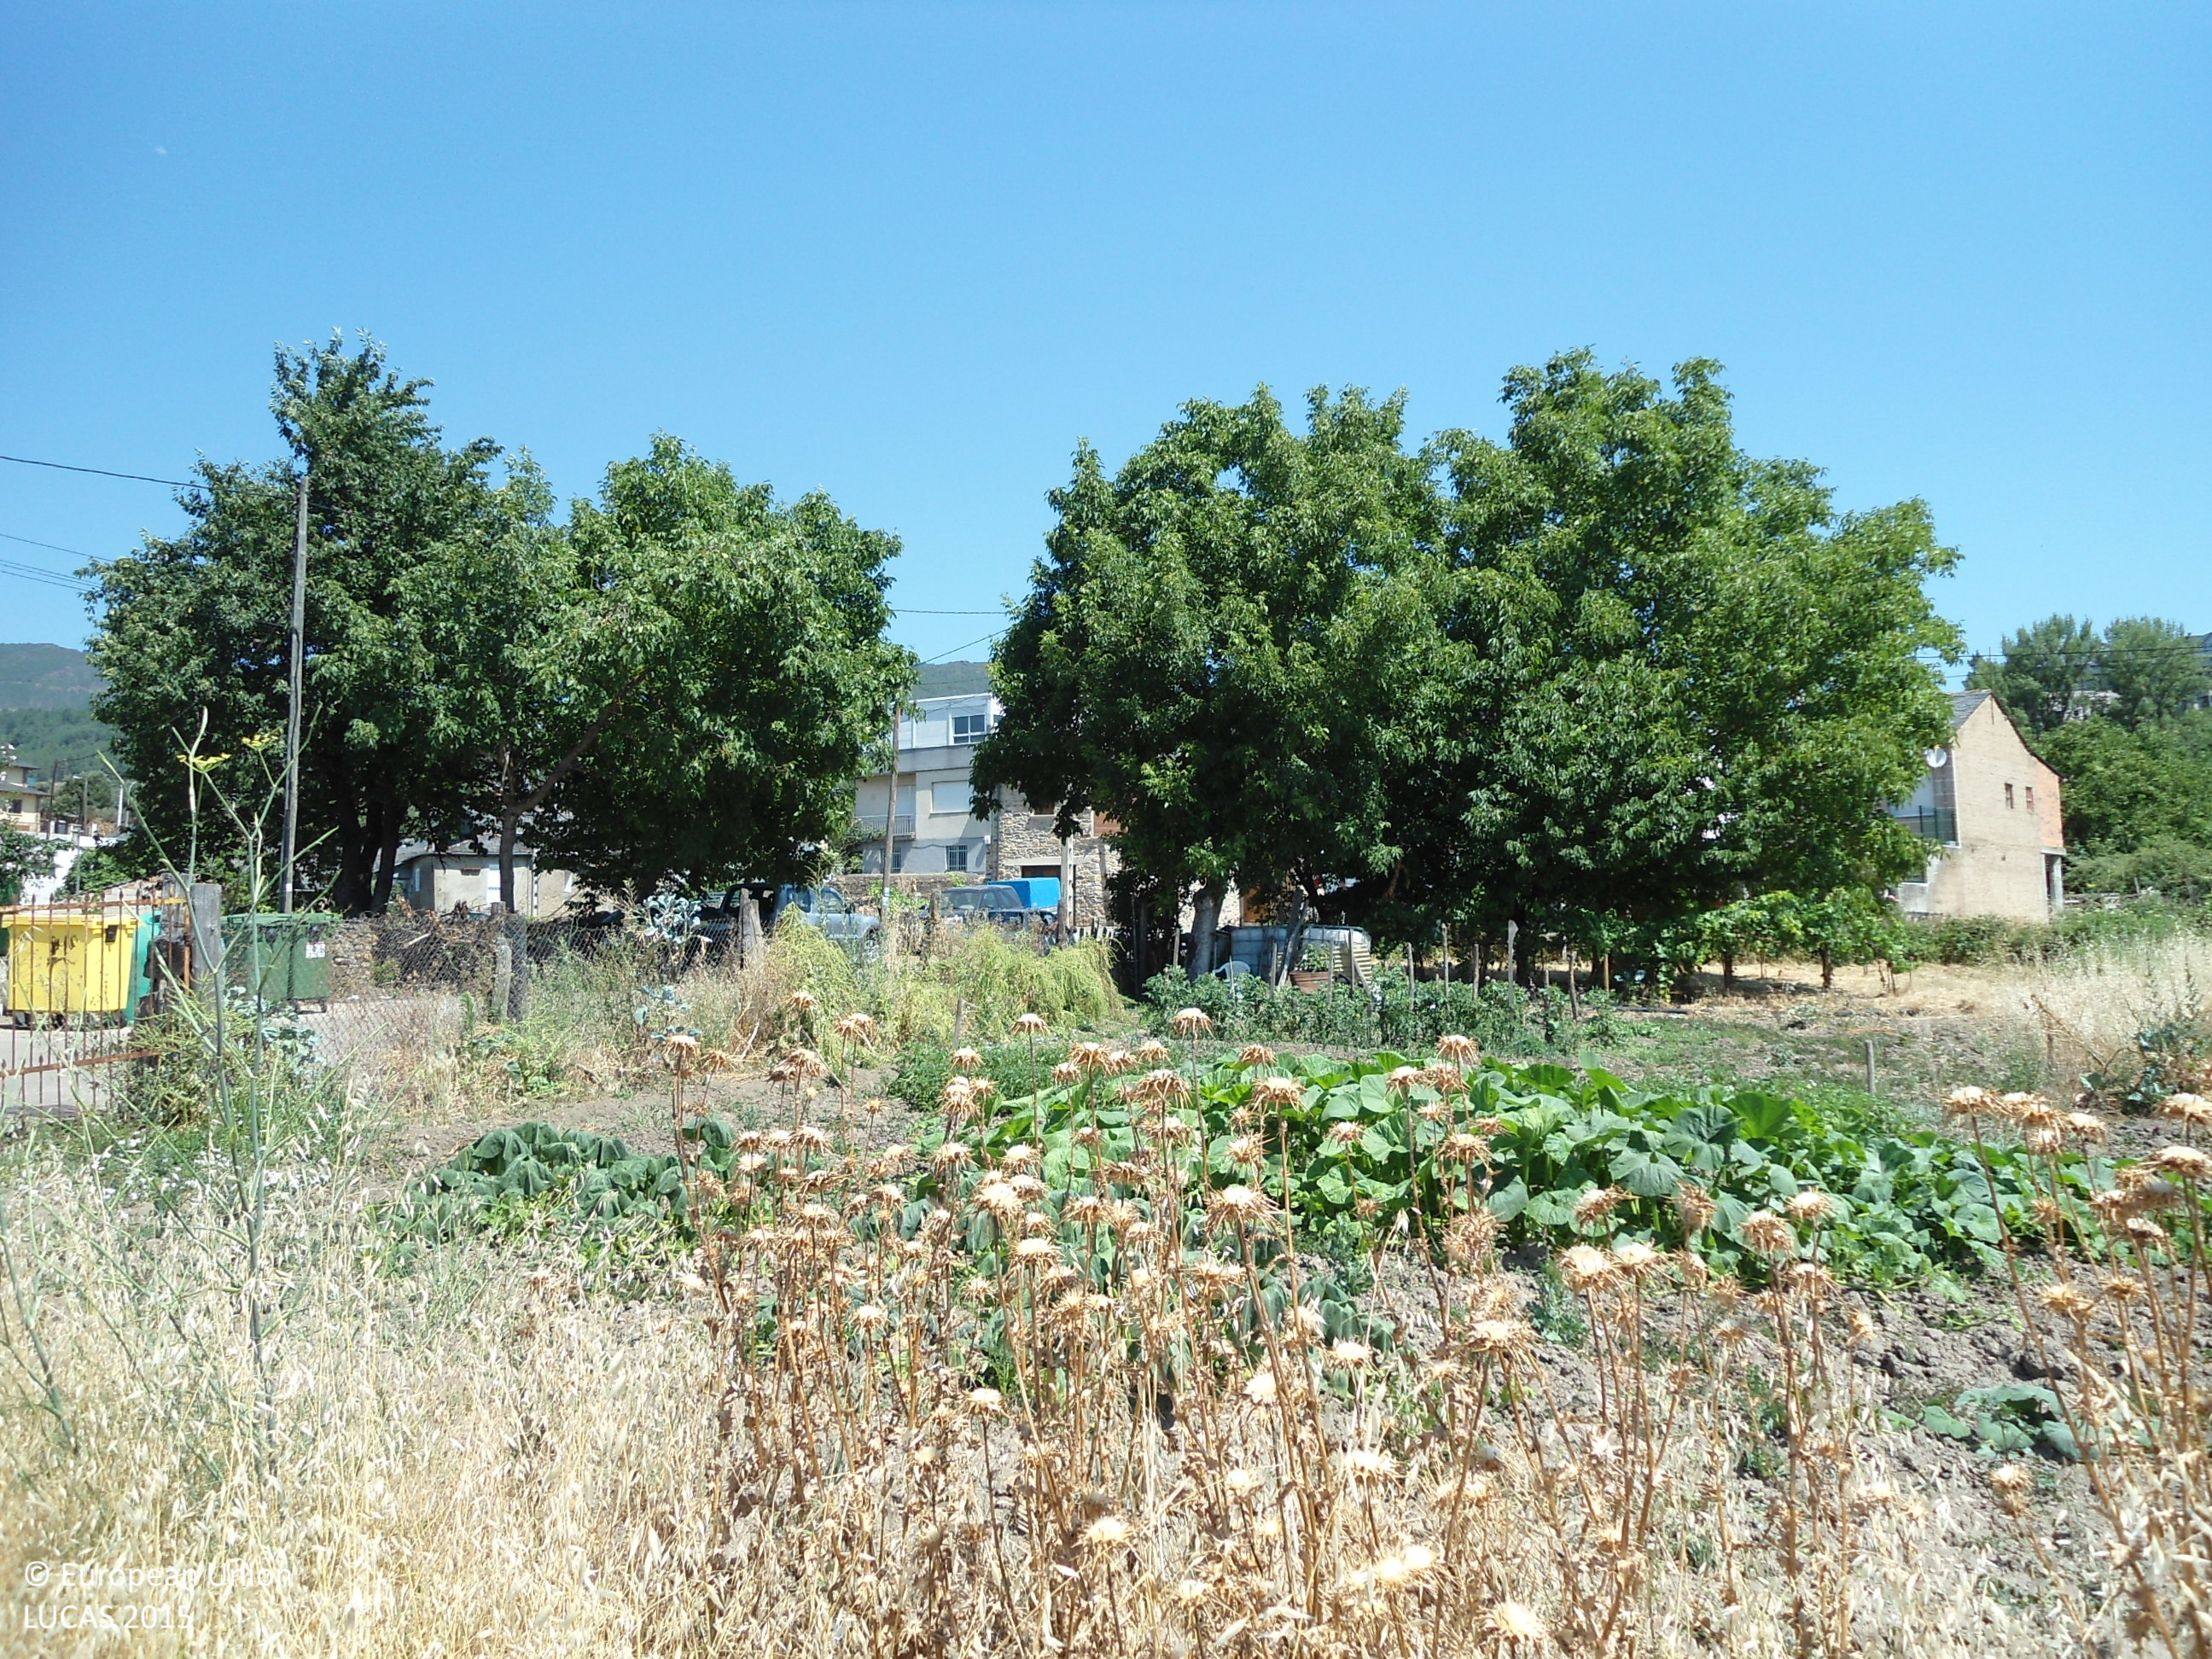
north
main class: Grassland
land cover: Spontaneously vegetated surfaces
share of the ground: > 75 %
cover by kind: herbaceous plants 100 %
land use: Semi-natural and natural areas not in use
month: June
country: ES
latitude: 42.4225
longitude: -6.9844
